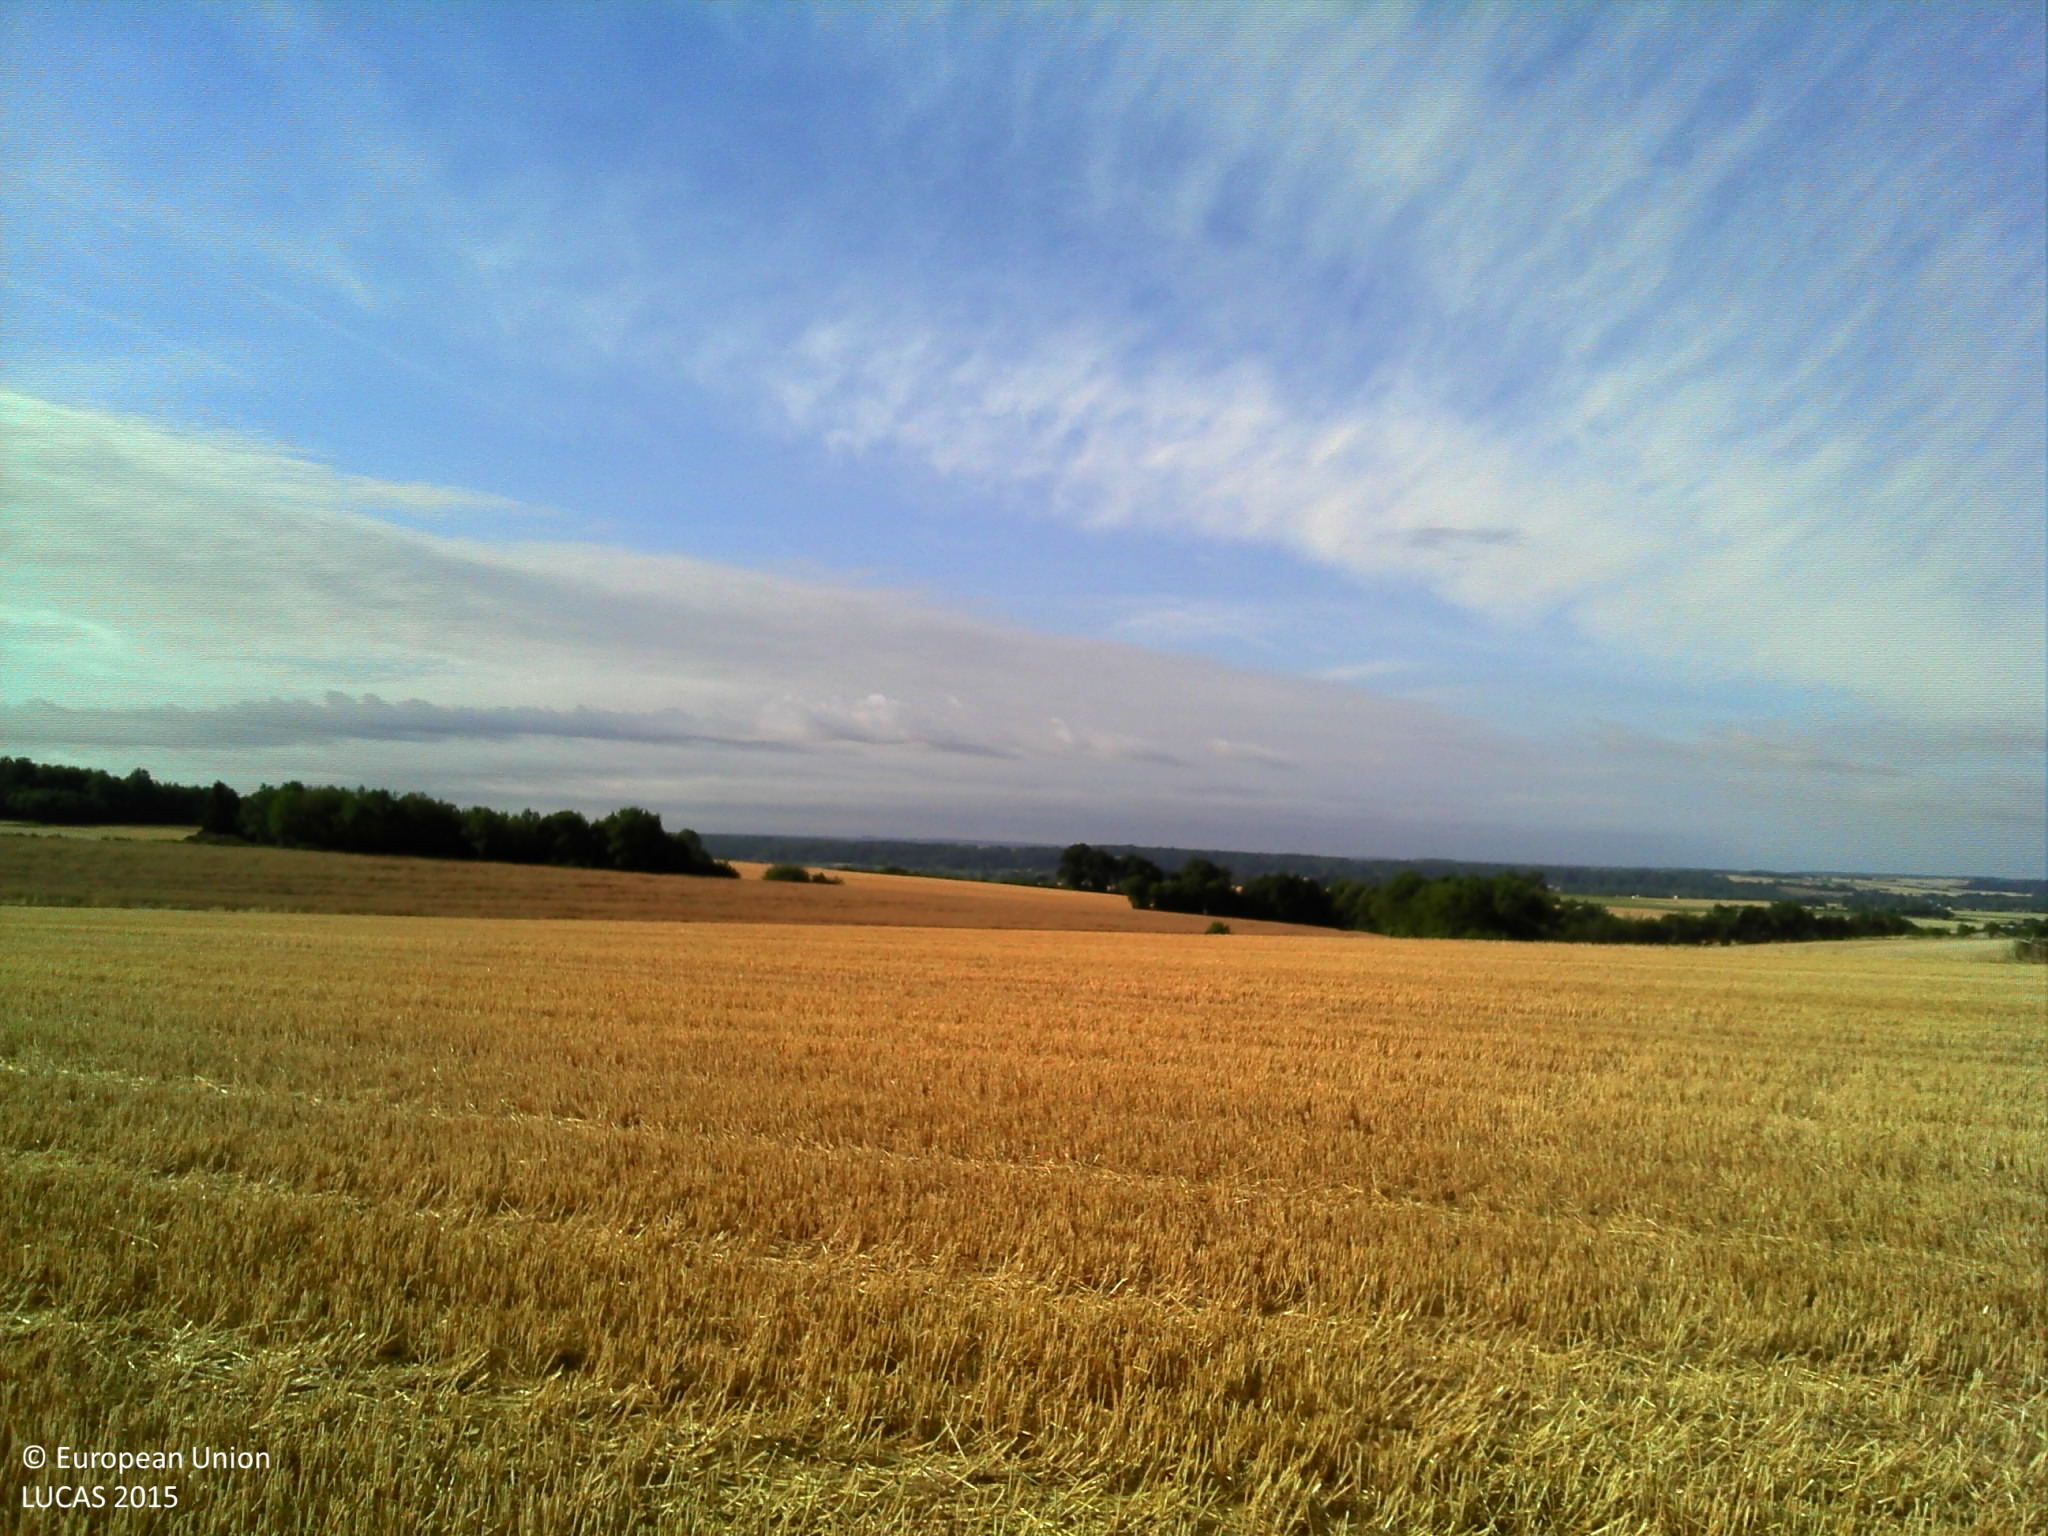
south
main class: Cropland
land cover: Common wheat
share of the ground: > 75 %
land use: Agriculture (excluding fallow land and kitchen gardens)
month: July
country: FR
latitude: 47.7890
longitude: 0.6482
